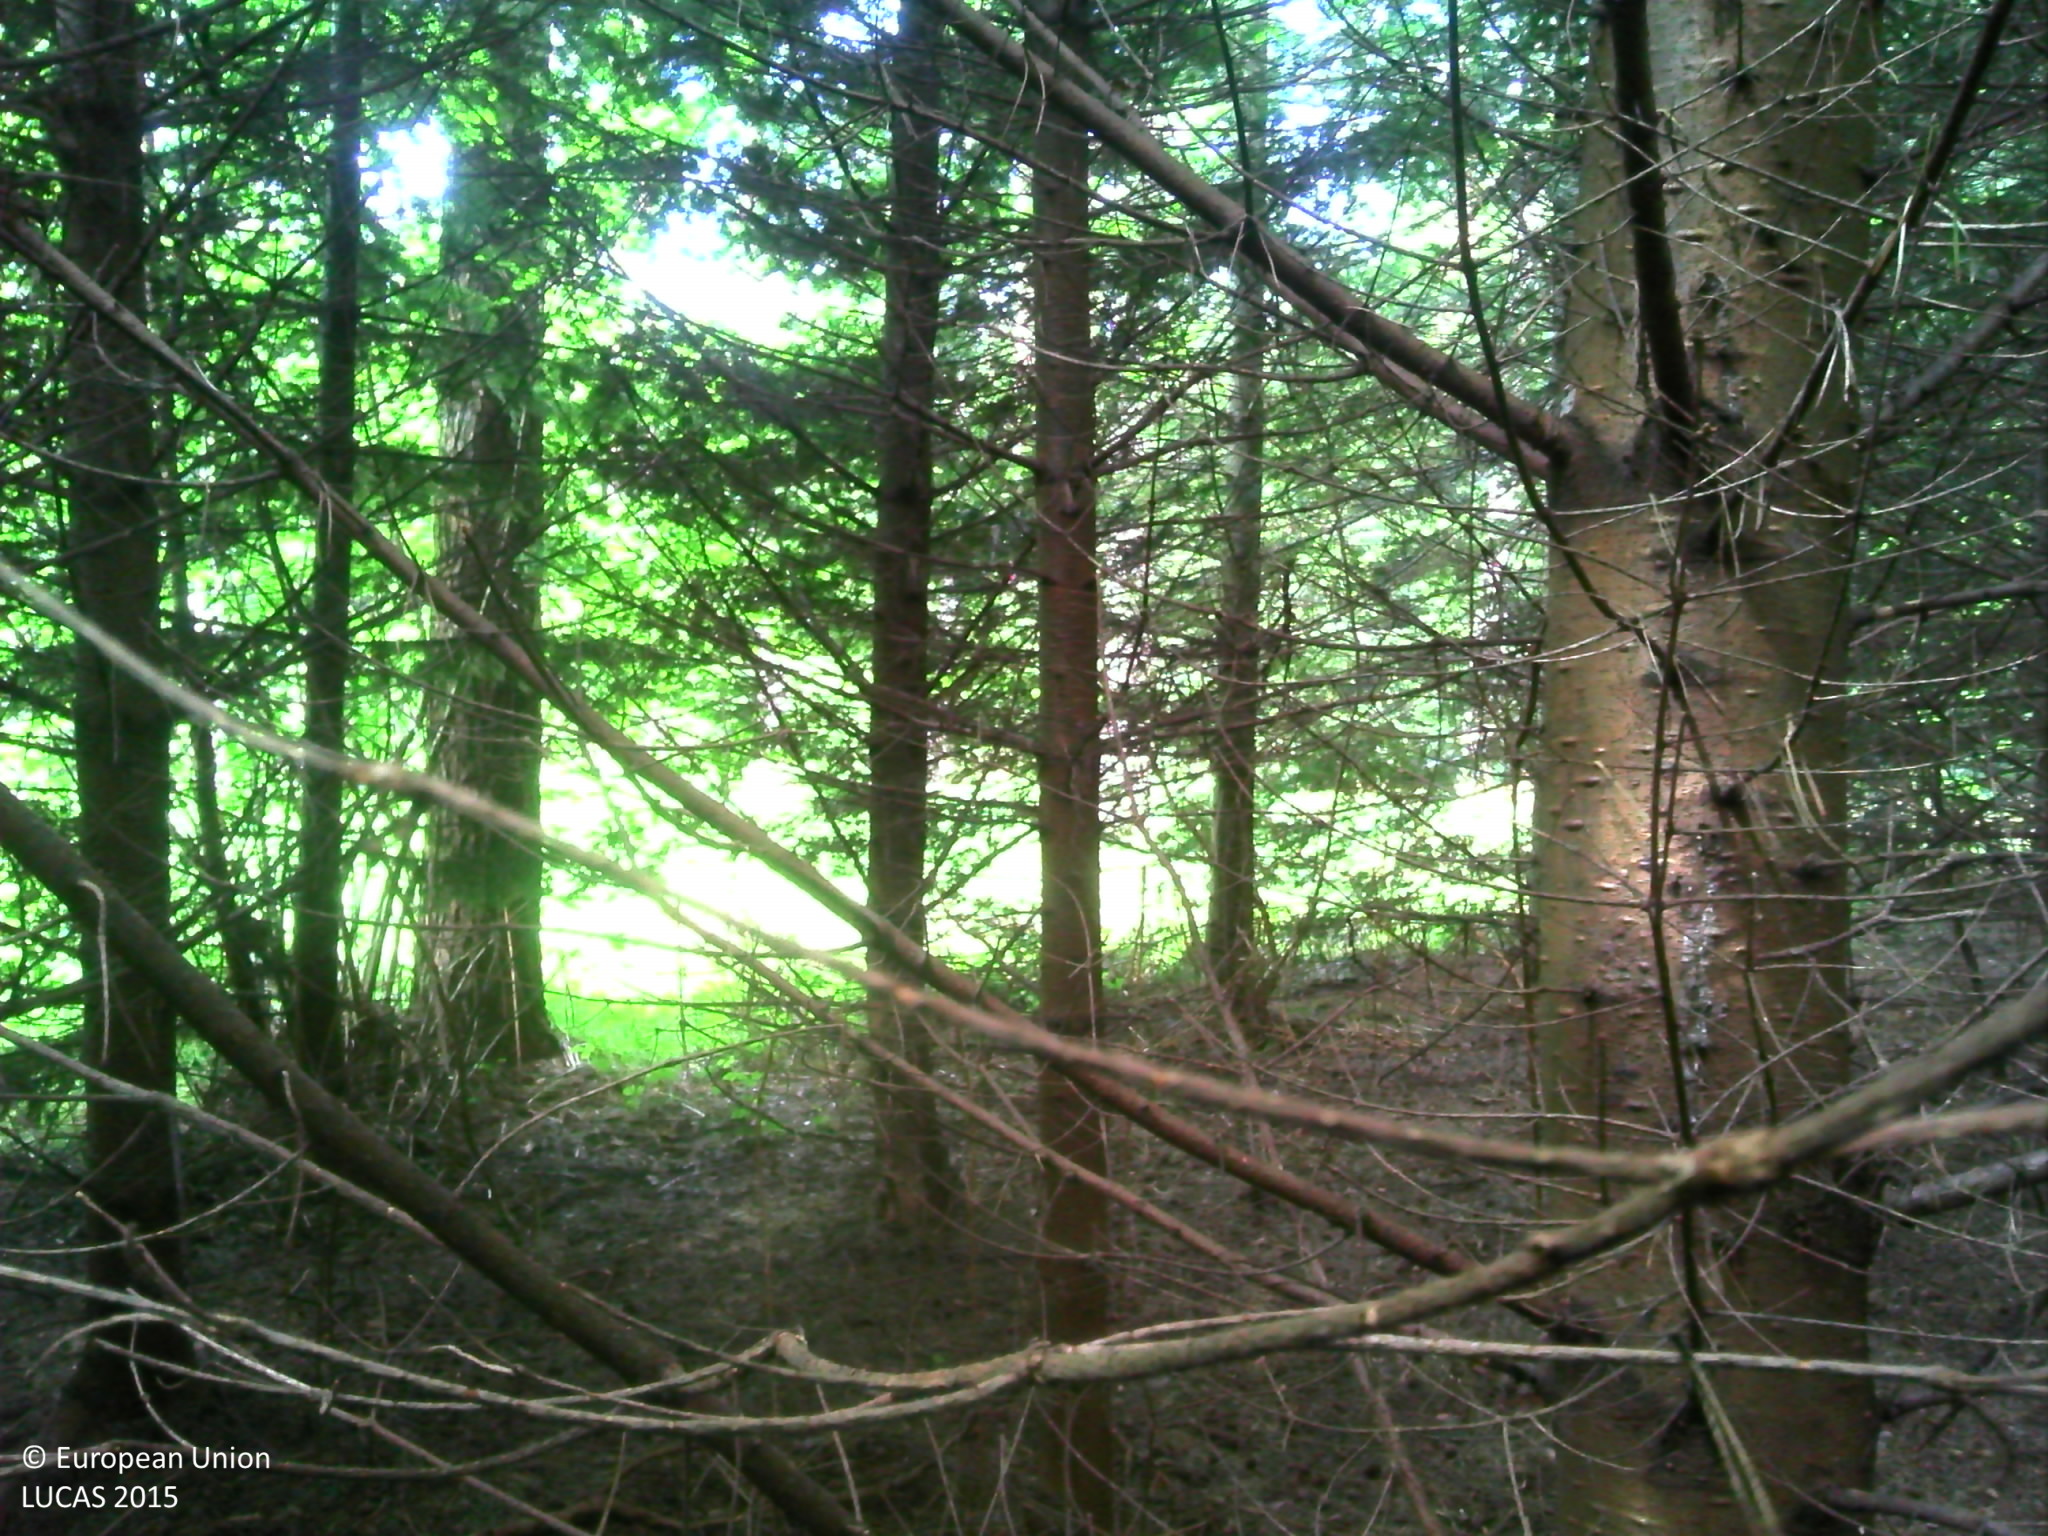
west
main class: Woodland
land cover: Other coniferous woodland
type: hemiboreal forest and nemoral coniferous forest and mixed broadleaved-coniferous forest
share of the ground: > 75 %
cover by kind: coniferous forest trees 95 %, broadleaved forest trees 5 %
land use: Forestry
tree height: > 5 m
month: June
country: BE
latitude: 49.9804
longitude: 4.9070
